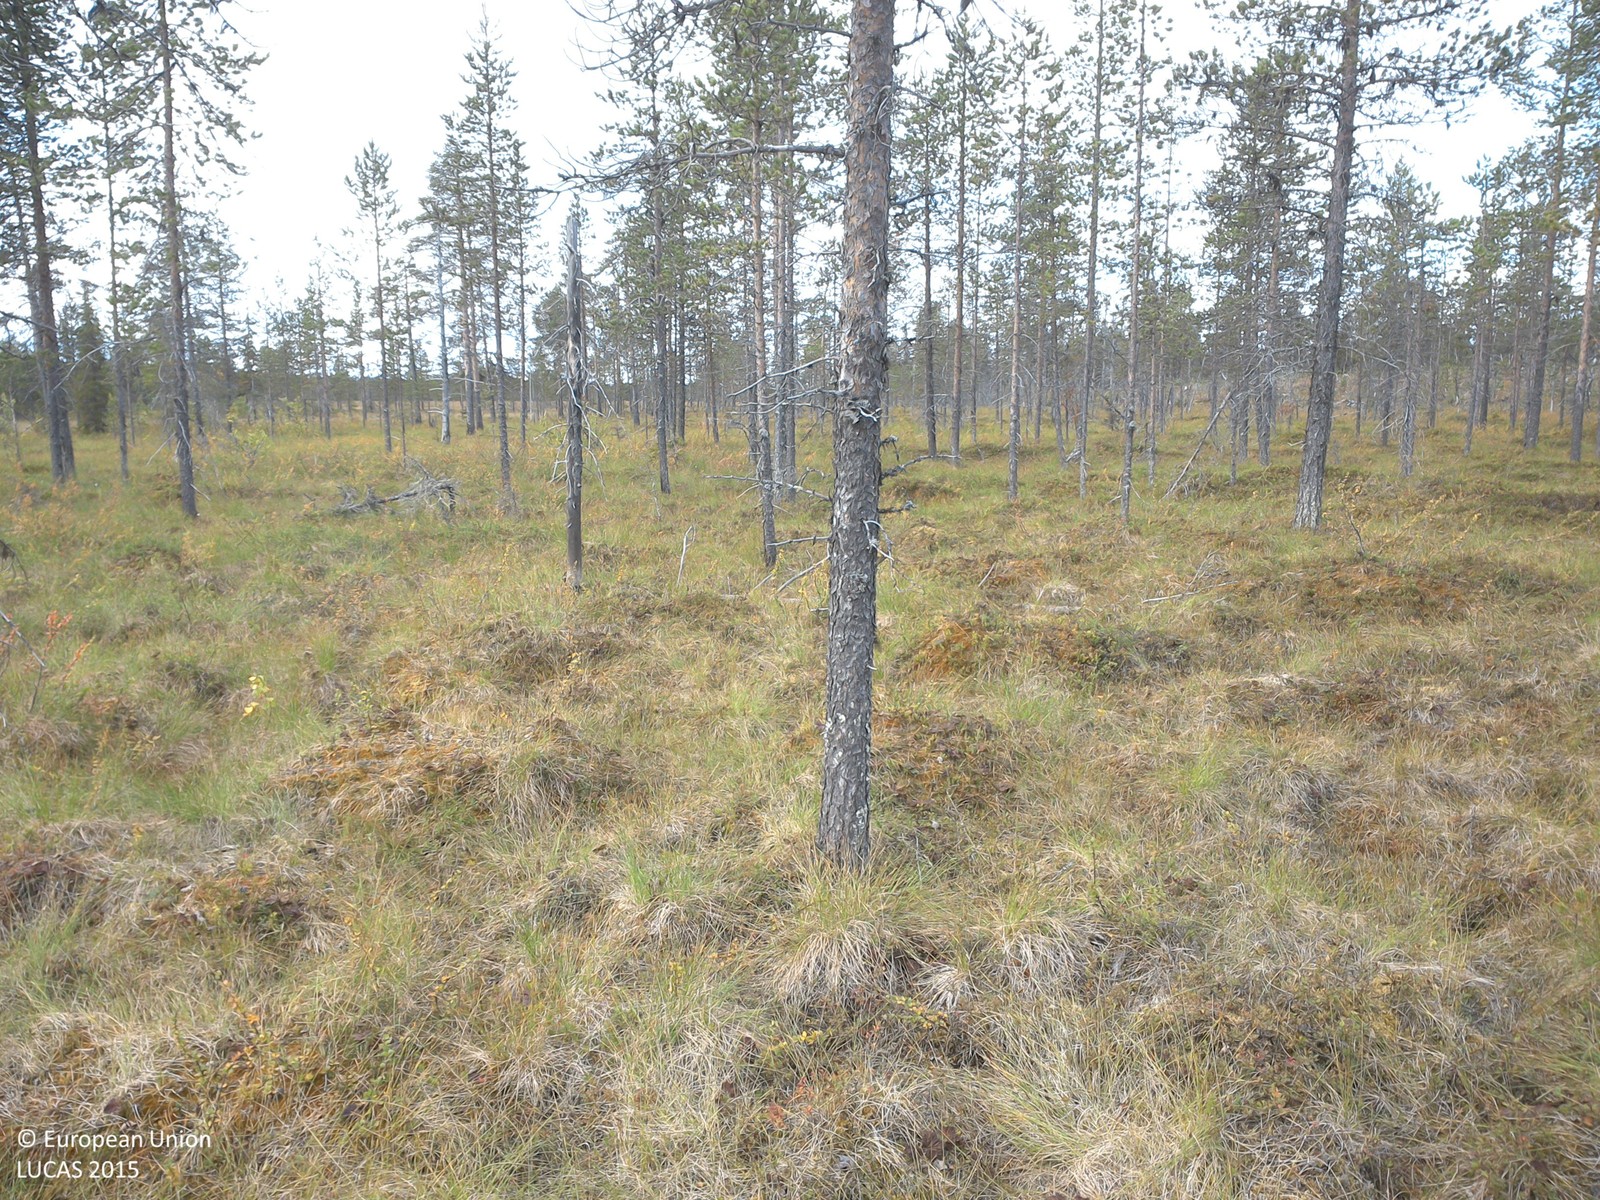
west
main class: Woodland
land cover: Pine dominated coniferous woodland
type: boreal forest
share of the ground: 10 - 25 %
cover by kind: shrubs 60 %, coniferous forest trees 15 %, lichens and mosses 15 %, herbaceous plants 10 %
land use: Forestry
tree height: > 5 m
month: September
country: SE
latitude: 67.8627
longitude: 23.1091
